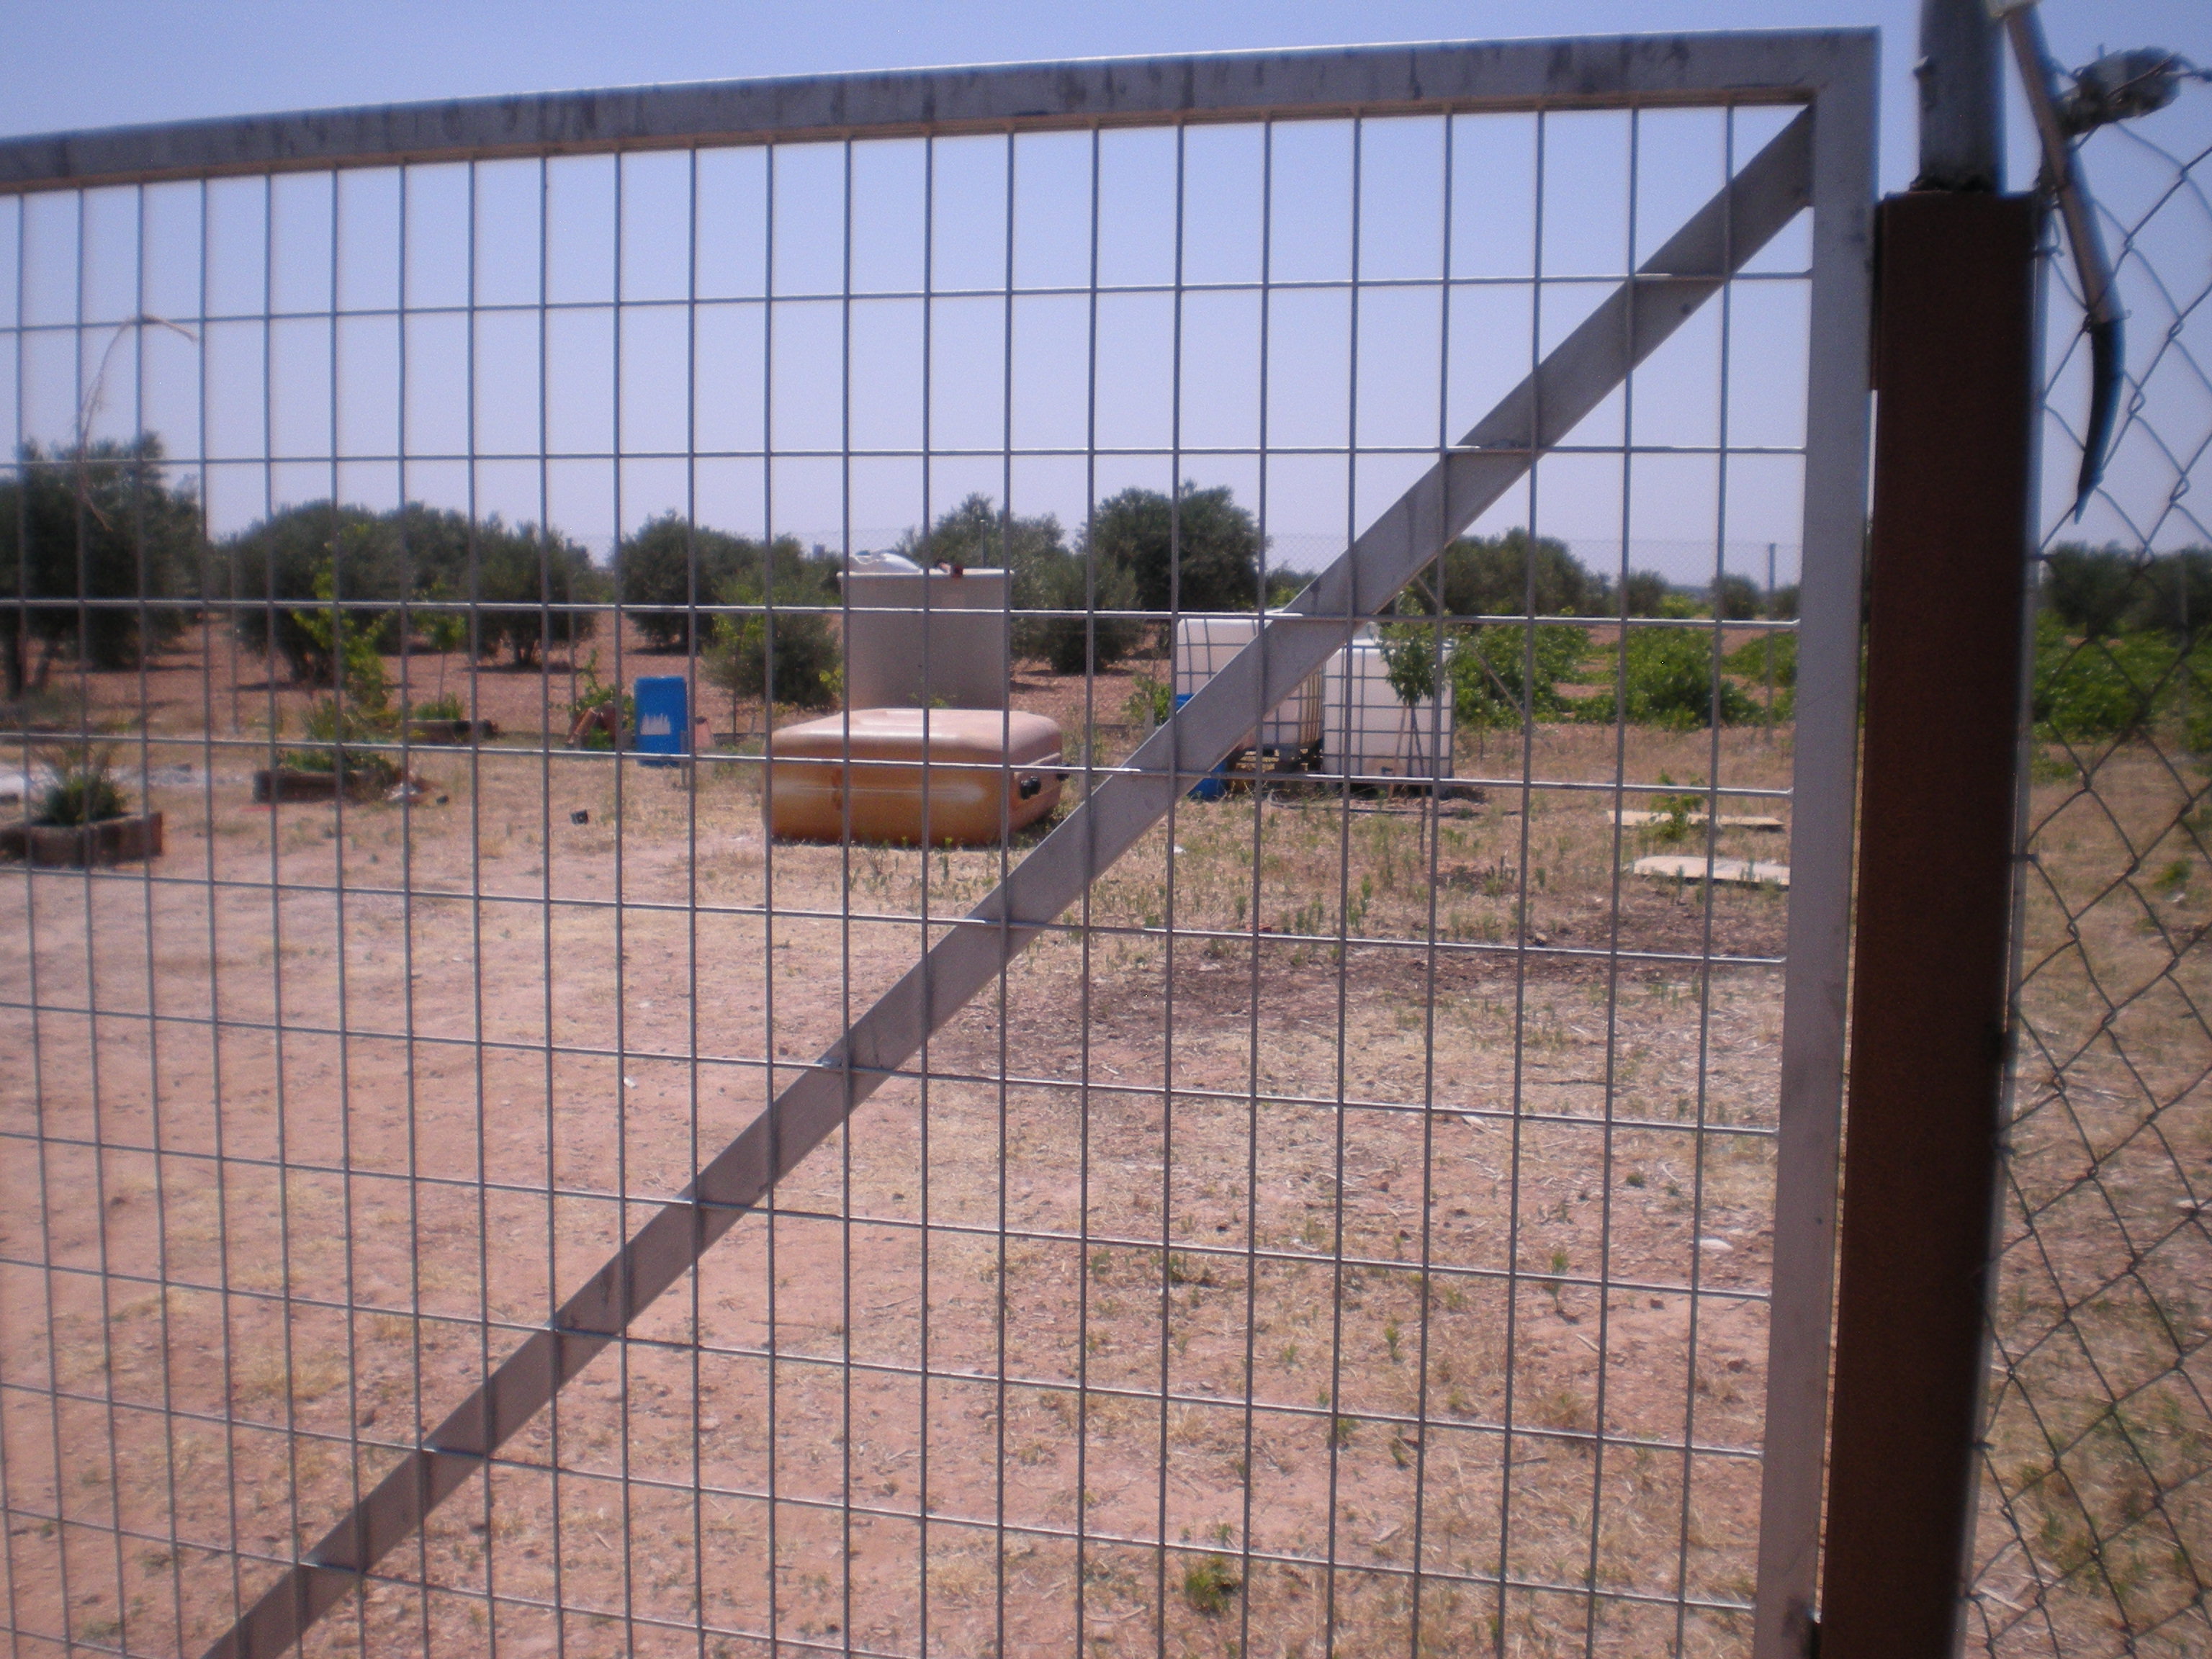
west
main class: Cropland
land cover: Olive groves
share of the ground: < 10 %
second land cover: Spontaneously vegetated surfaces
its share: 10 - 25 %
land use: Agriculture (excluding fallow land and kitchen gardens)
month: July
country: ES
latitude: 39.6047
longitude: -3.0985
